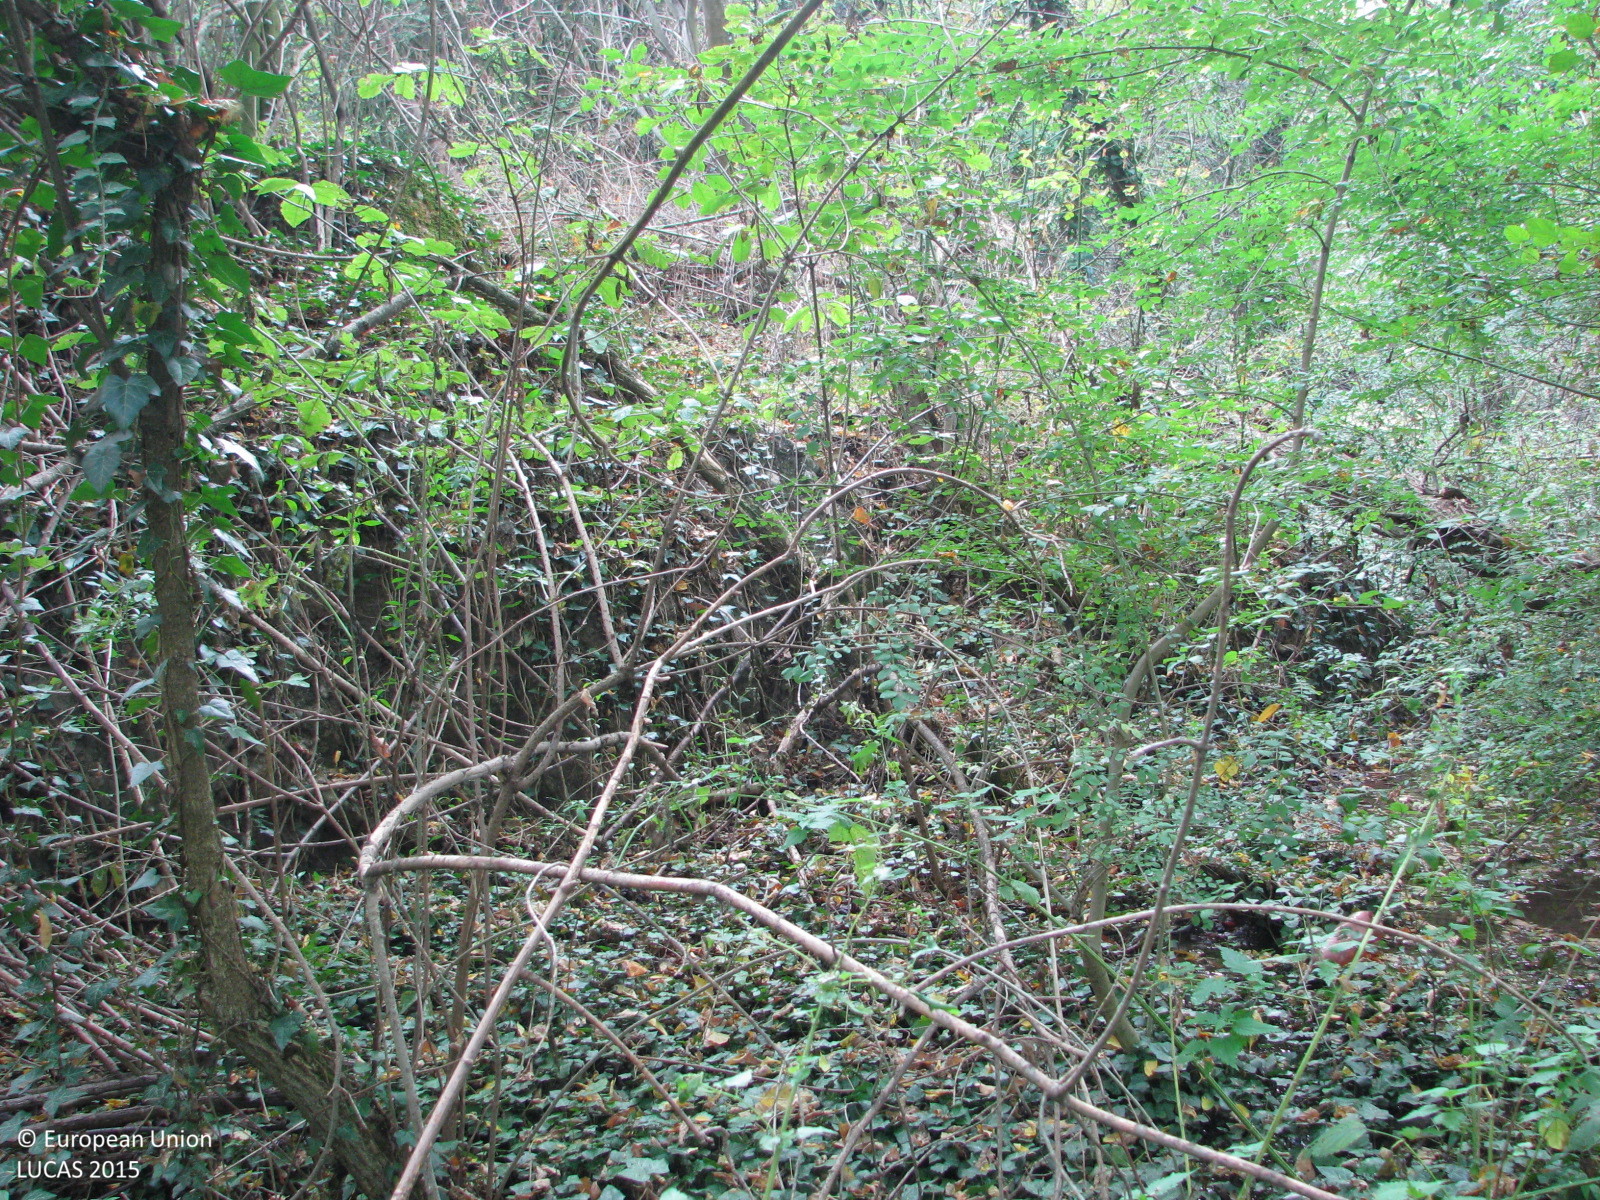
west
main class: Woodland
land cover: Broadleaved woodland
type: mesophytic deciduous forest
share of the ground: 50 - 75 %
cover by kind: broadleaved forest trees 60 %, shrubs 30 %, herbaceous plants 10 %
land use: Forestry
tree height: > 5 m
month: October
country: BG
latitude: 42.4261
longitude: 26.1885
